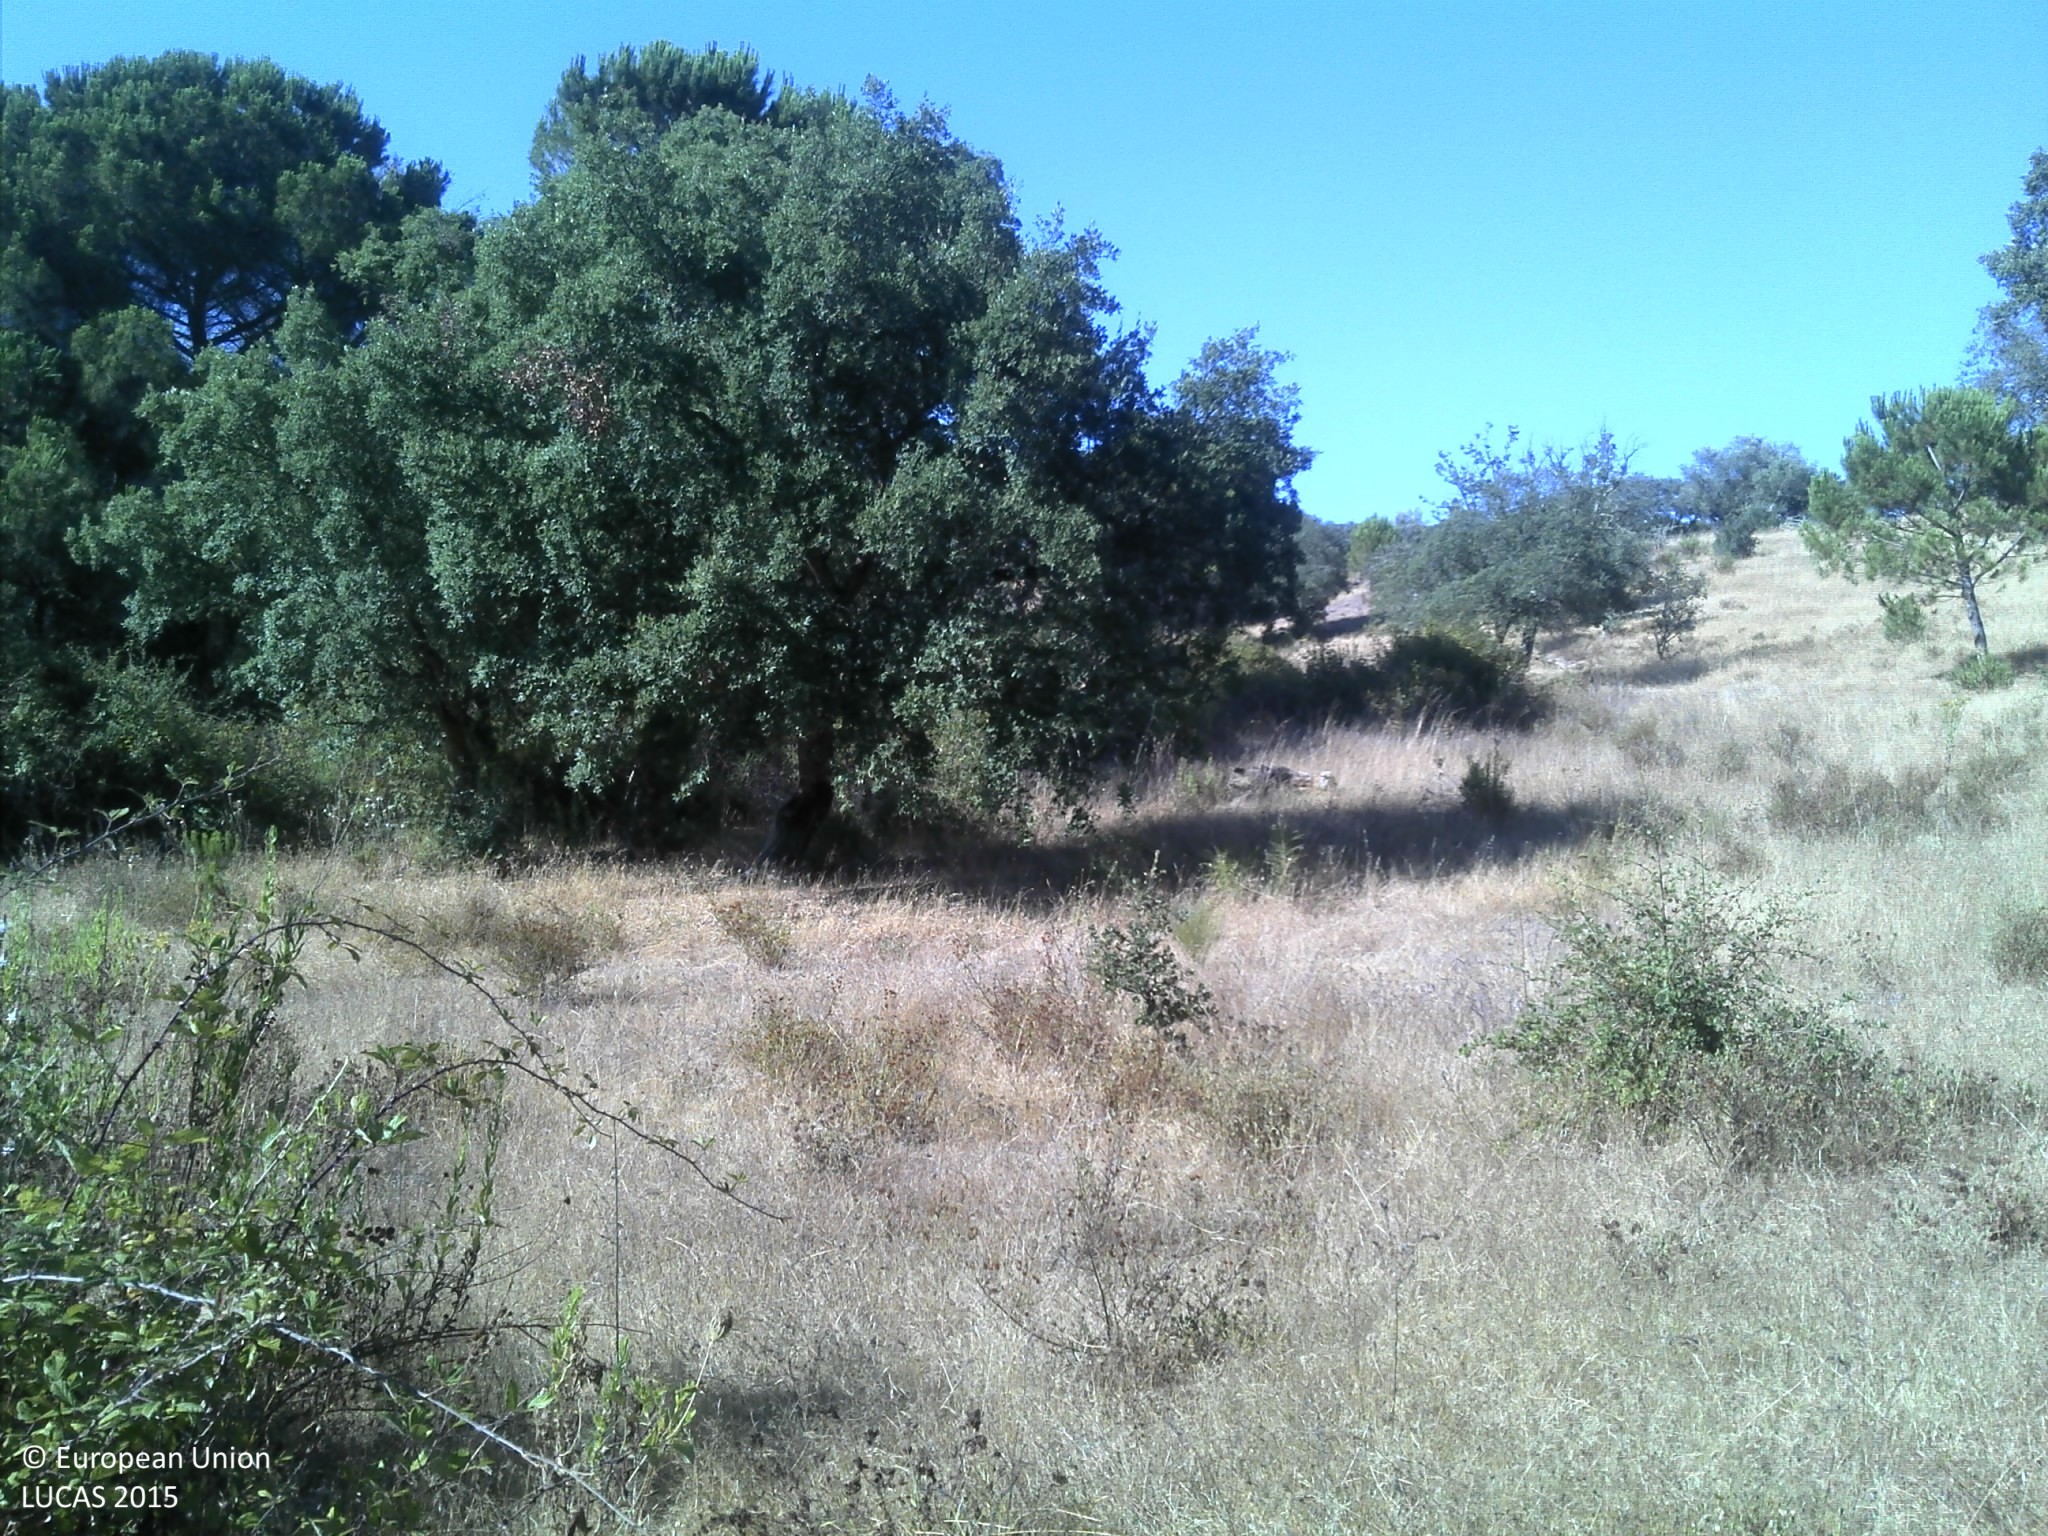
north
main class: Woodland
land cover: Broadleaved woodland
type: broadleaved evergreen forest
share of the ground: 25 - 50 %
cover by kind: broadleaved forest trees 40 %, unconsolidated bare surface 35 %, herbaceous plants 20 %, shrubs 5 %
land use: Forestry
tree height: > 5 m
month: July
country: PT
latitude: 38.9721
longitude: -8.2106
